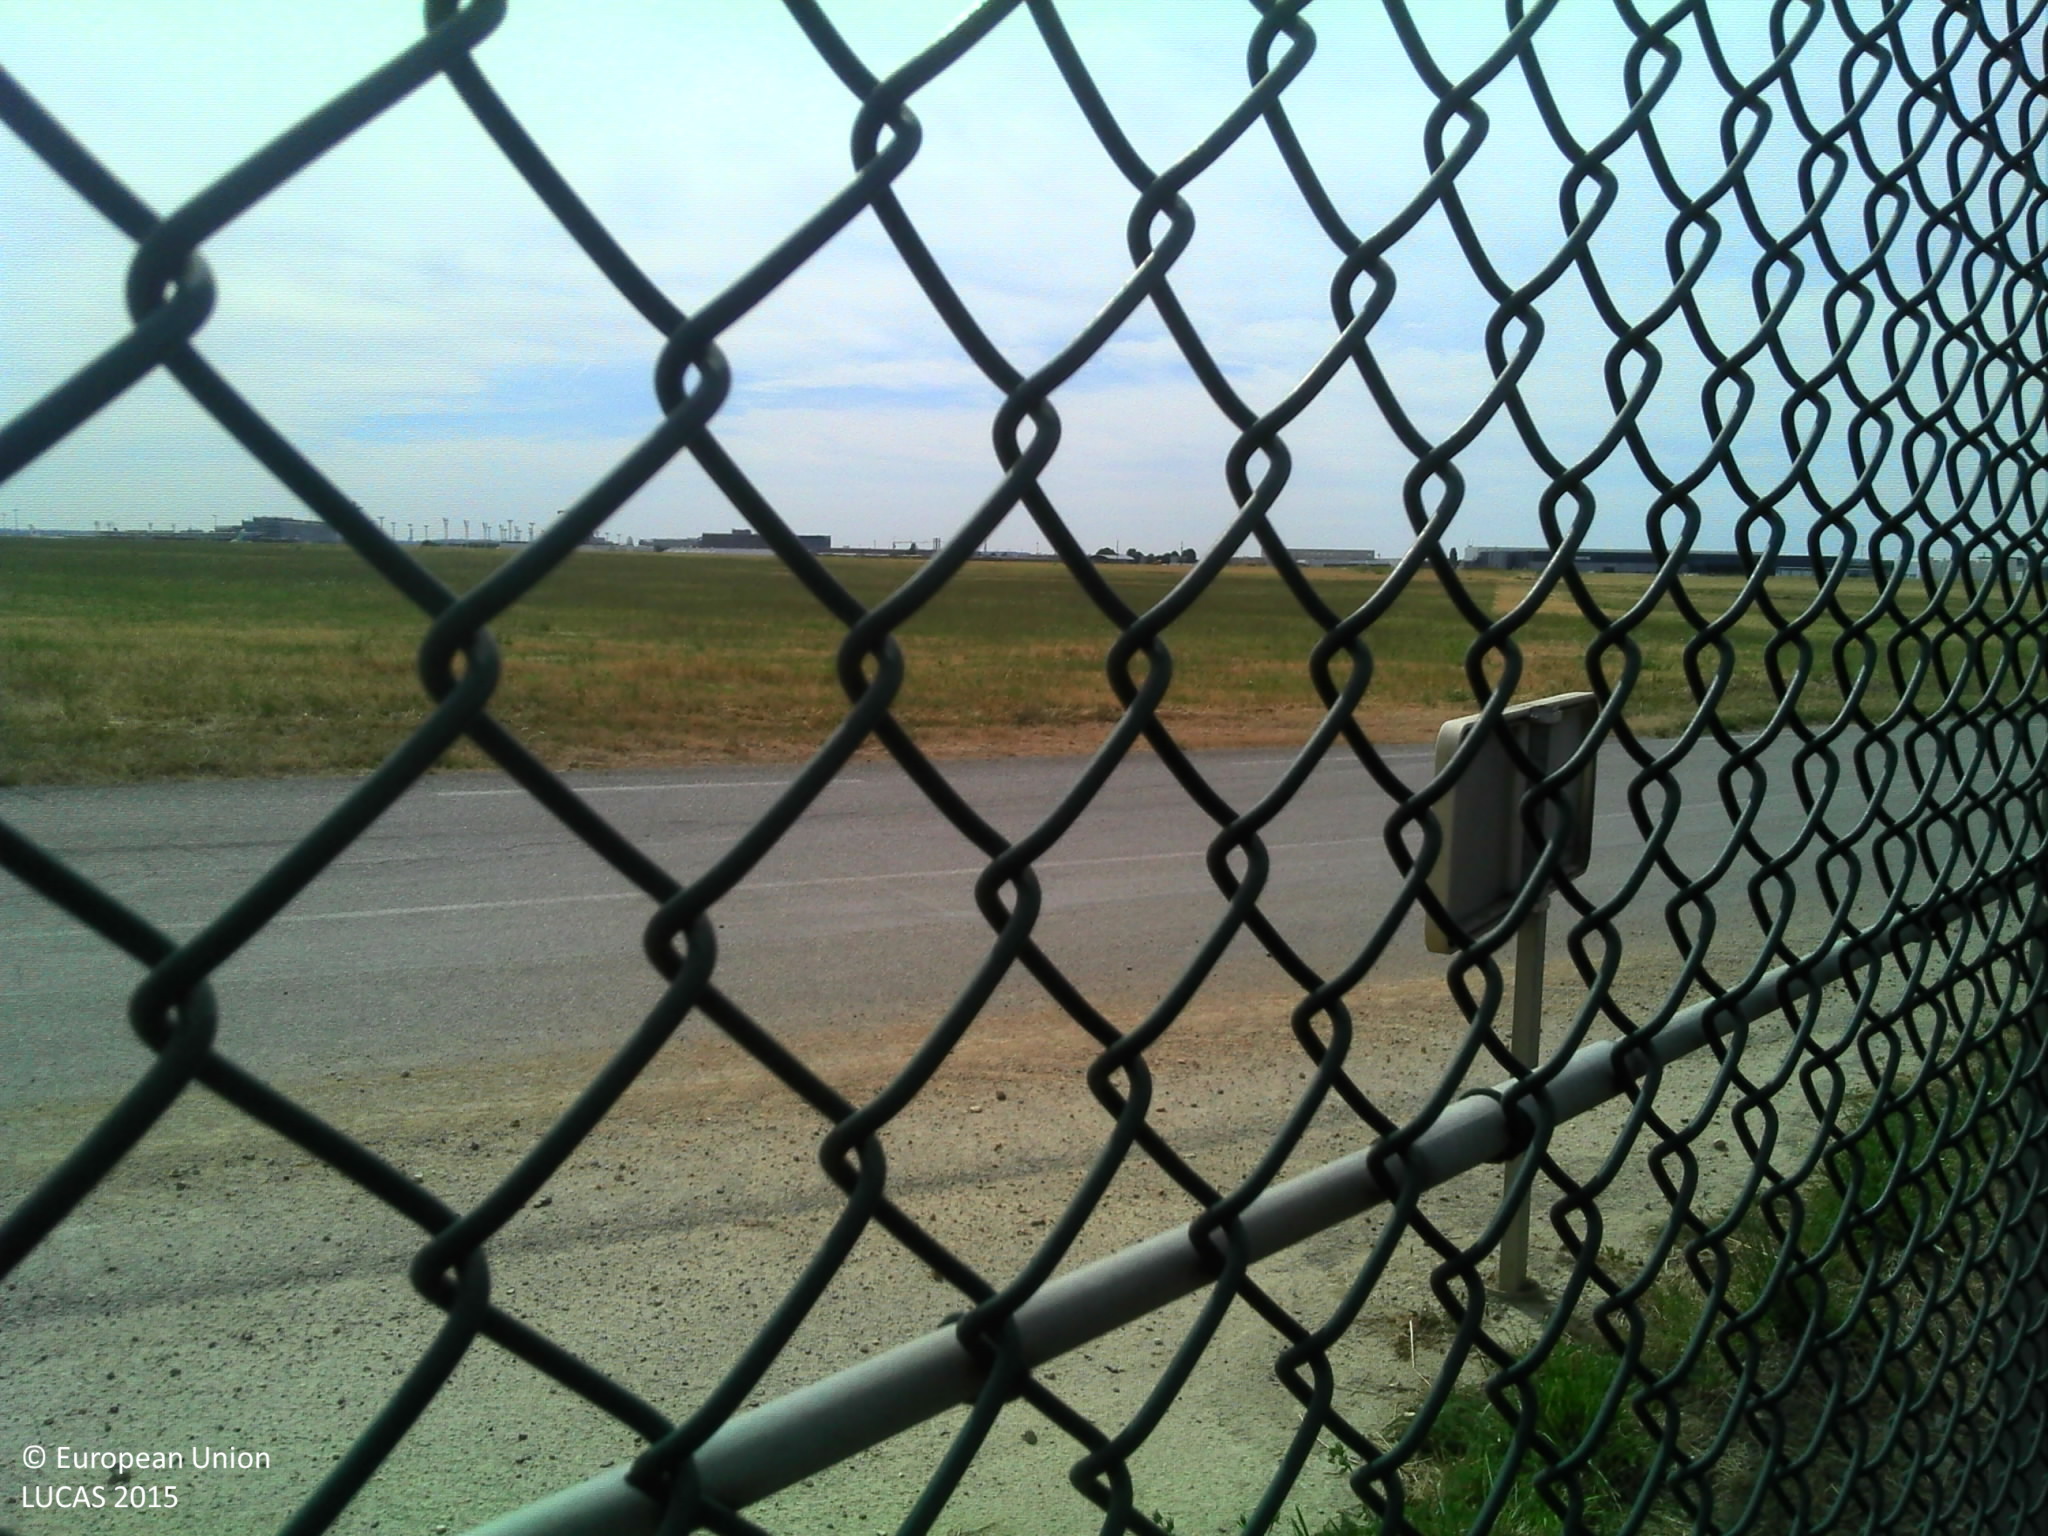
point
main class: Grassland
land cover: Grassland without tree/shrub cover
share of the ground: > 75 %
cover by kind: herbaceous plants 100 %
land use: Air transport
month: August
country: FR
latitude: 48.7372
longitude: 2.3874
